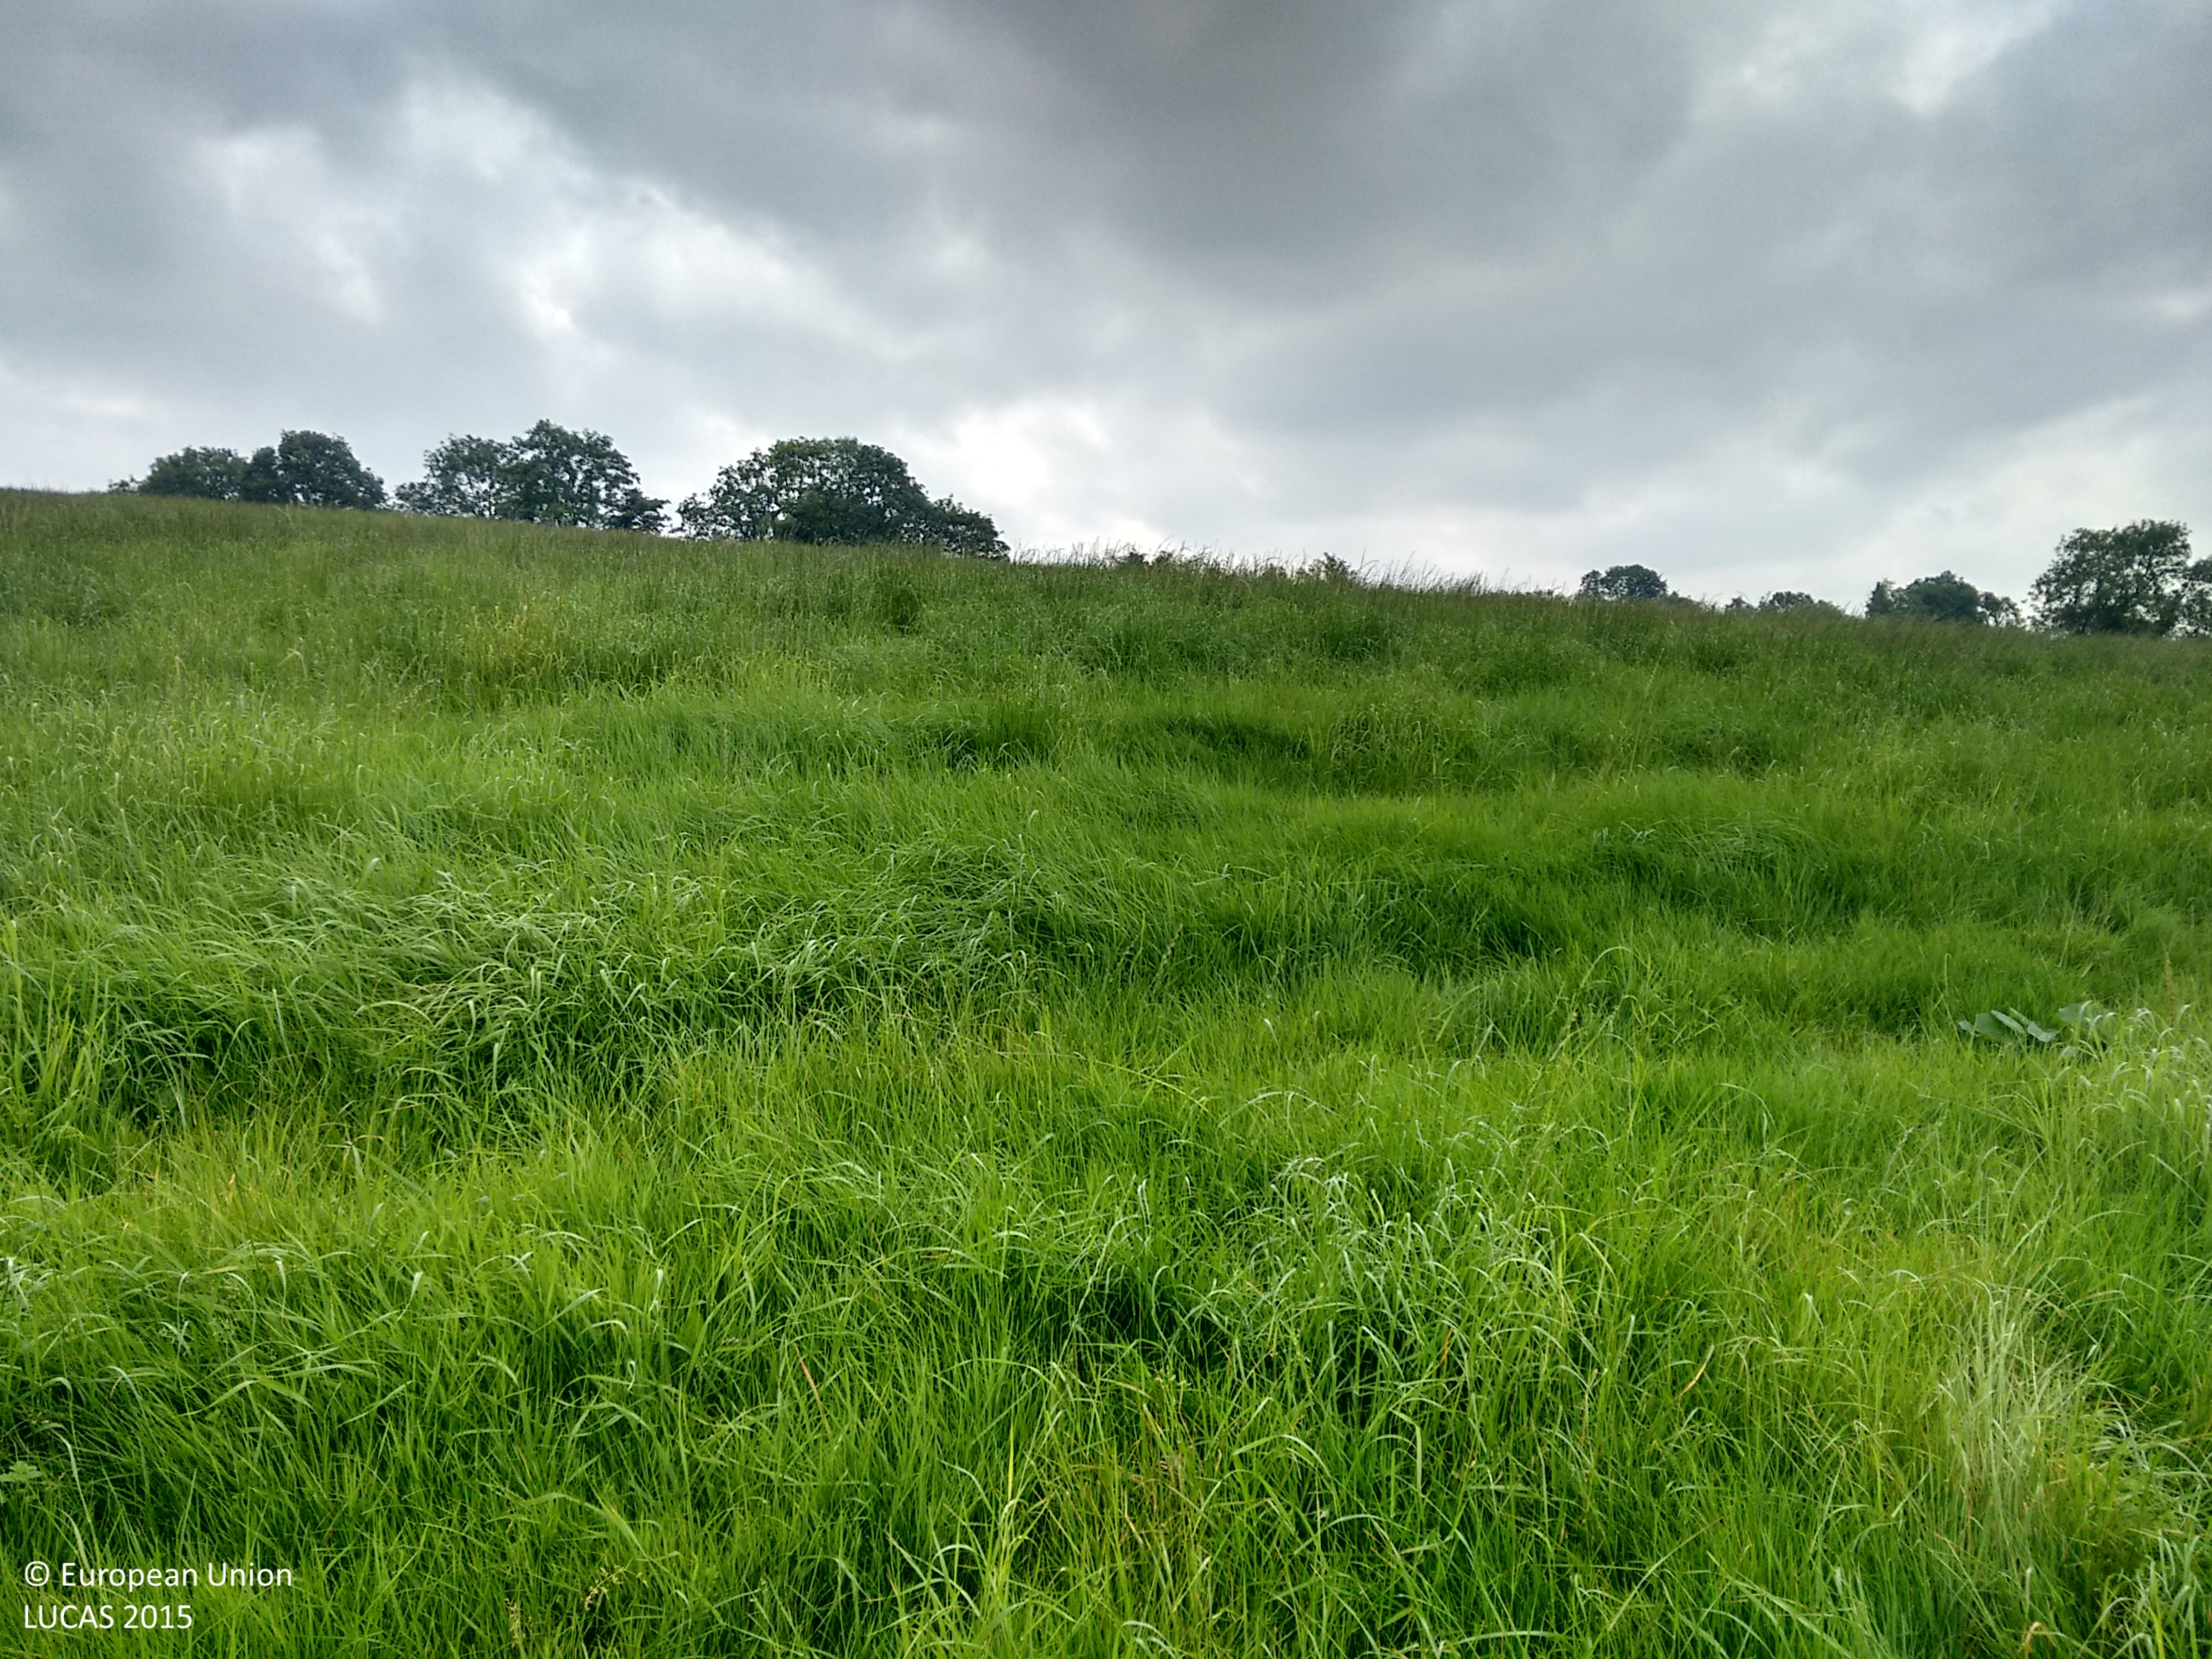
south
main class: Grassland
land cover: Grassland without tree/shrub cover
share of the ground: > 75 %
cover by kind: herbaceous plants 100 %
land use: Agriculture (excluding fallow land and kitchen gardens)
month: September
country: IE
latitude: 54.2738
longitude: -7.0811
